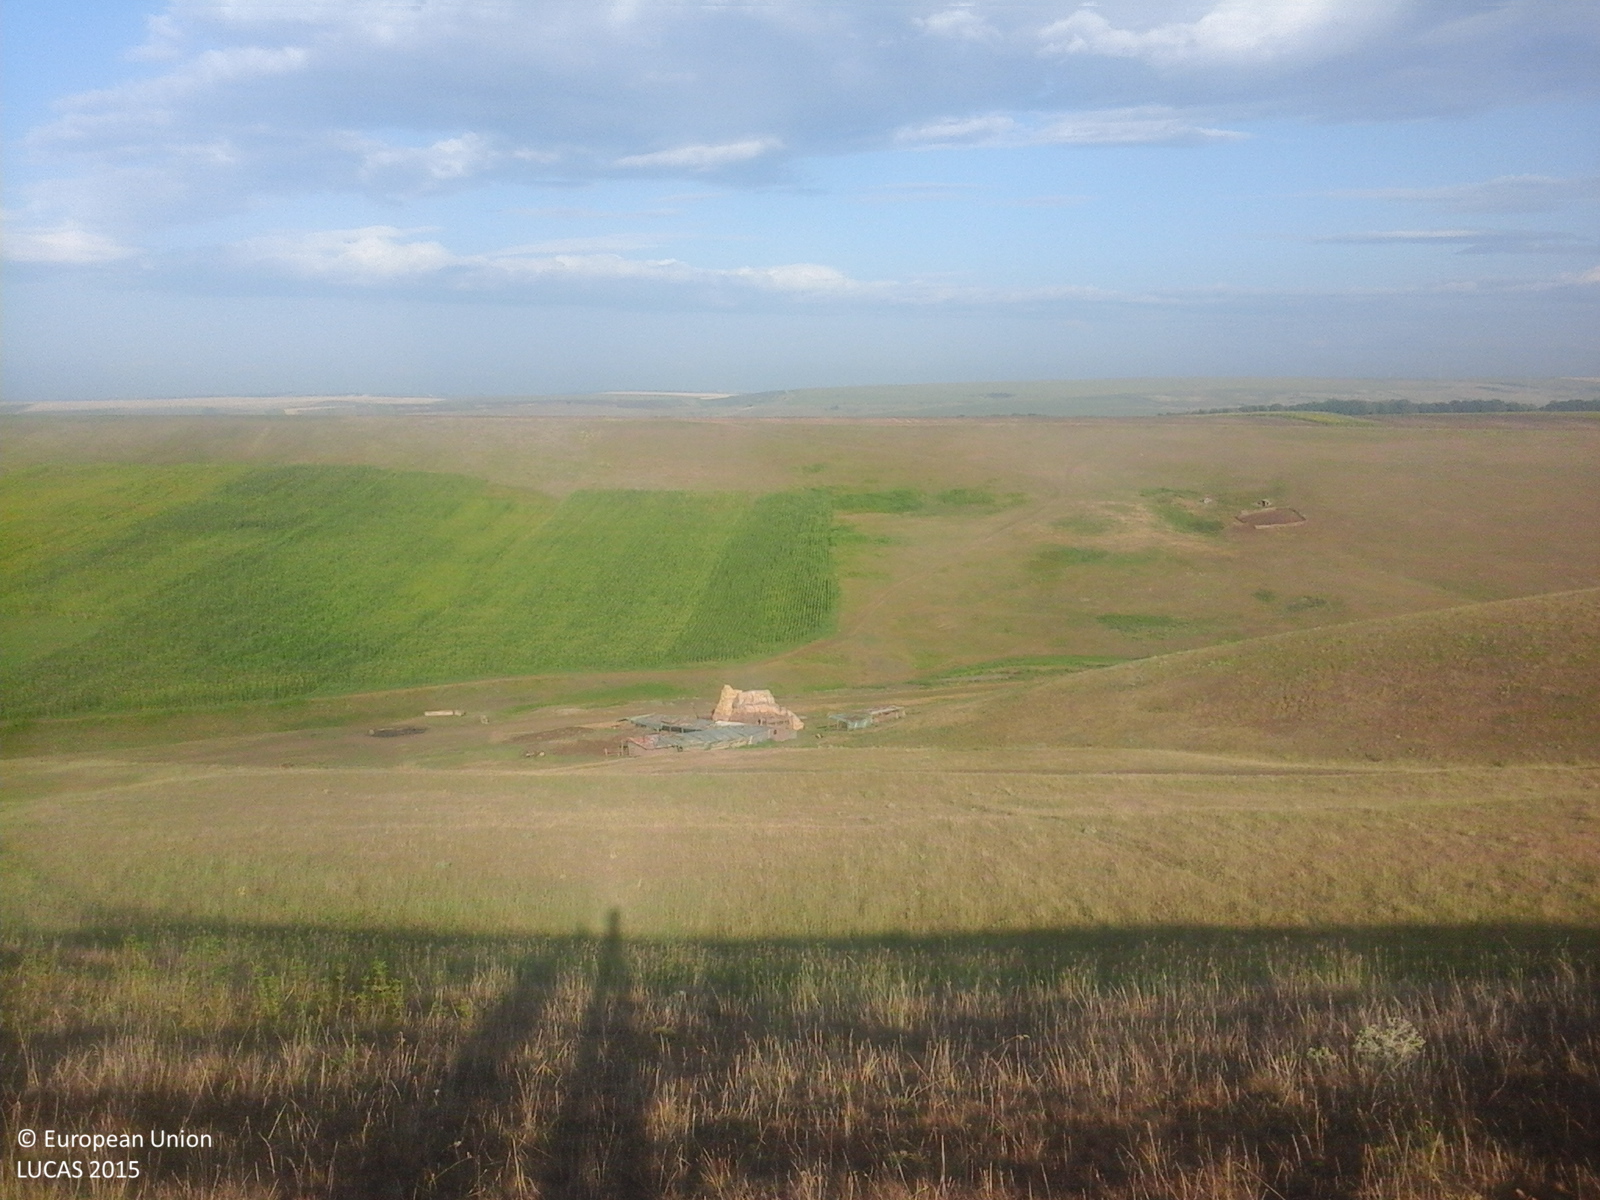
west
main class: Grassland
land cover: Grassland without tree/shrub cover
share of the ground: > 75 %
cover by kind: herbaceous plants 100 %
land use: Agriculture (excluding fallow land and kitchen gardens)
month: July
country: RO
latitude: 46.2256
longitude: 27.5750
